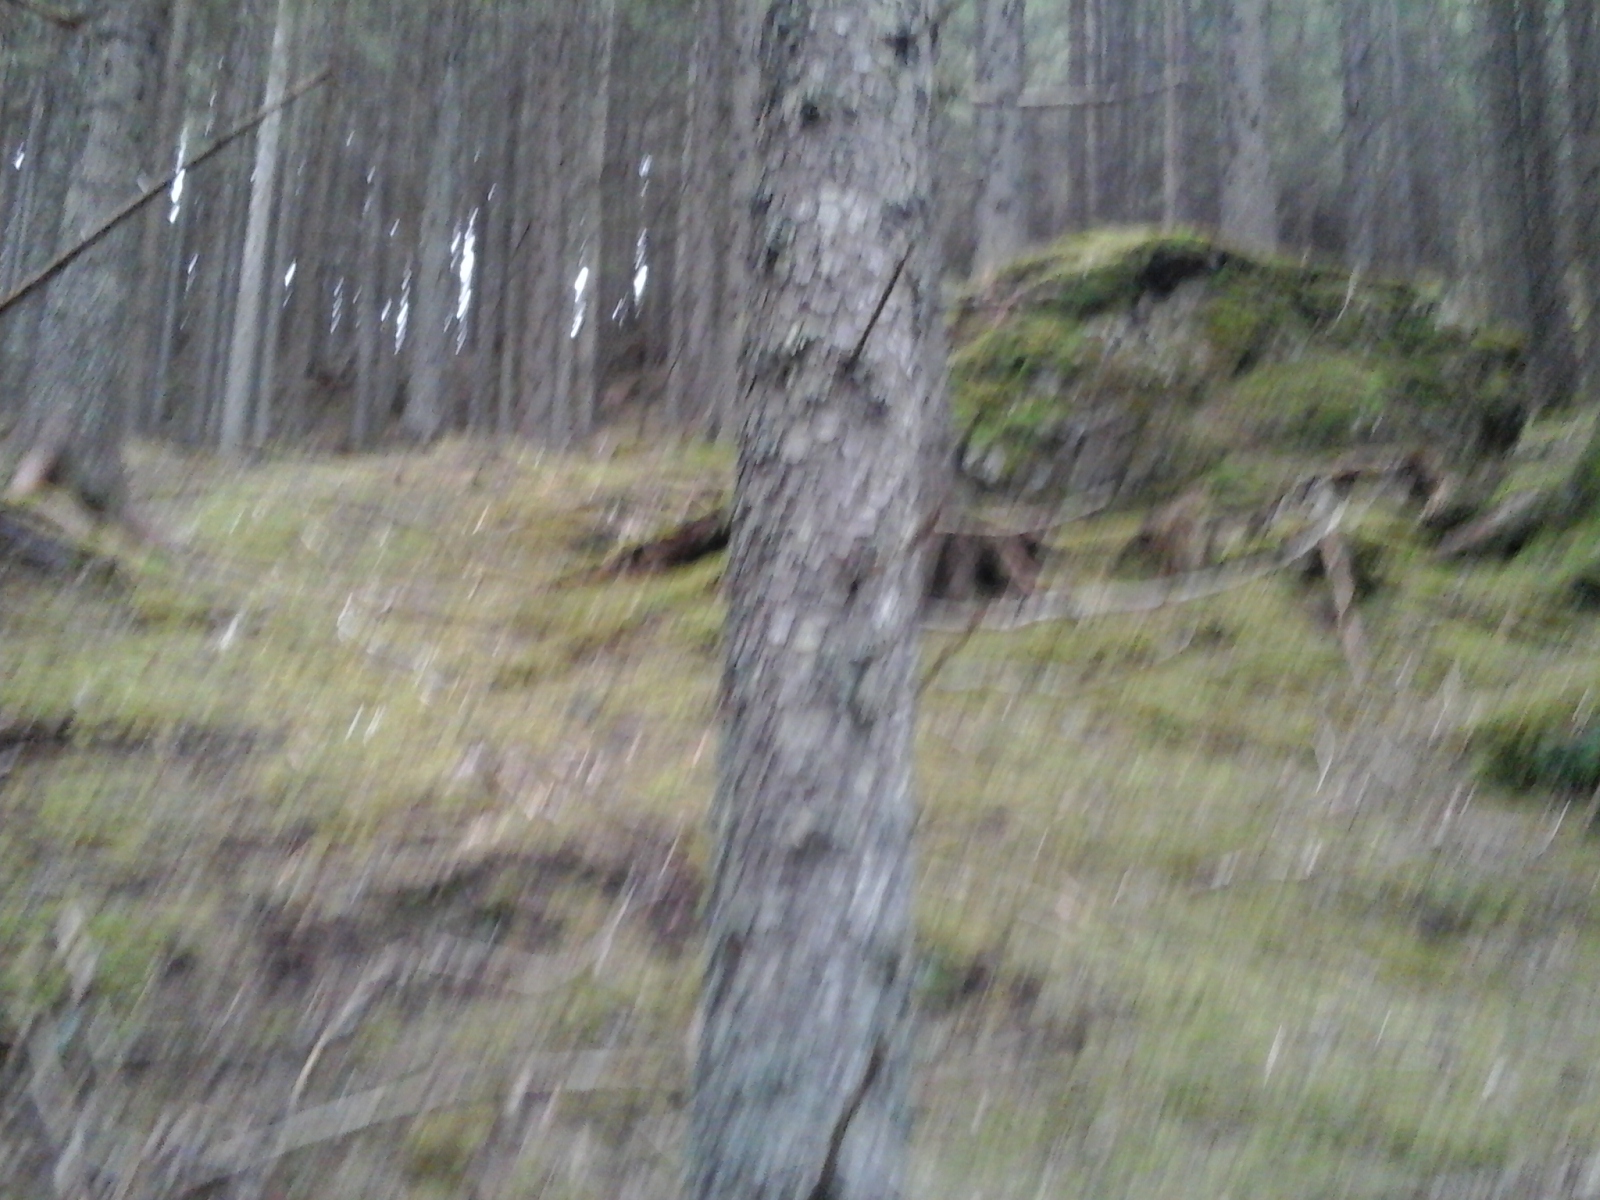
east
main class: Woodland
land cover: Spruce dominated coniferous woodland
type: alpine coniferous forest
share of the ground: > 75 %
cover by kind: coniferous forest trees 95 %, lichens and mosses 5 %
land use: Forestry
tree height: > 5 m
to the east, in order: Spruce dominated coniferous woodland; Tracks; Spruce dominated coniferous woodland; Grassland without tree/shrub cover; Fences; Other bare soil; Broadleaved woodland
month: May
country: IT
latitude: 46.4117
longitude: 11.5722
